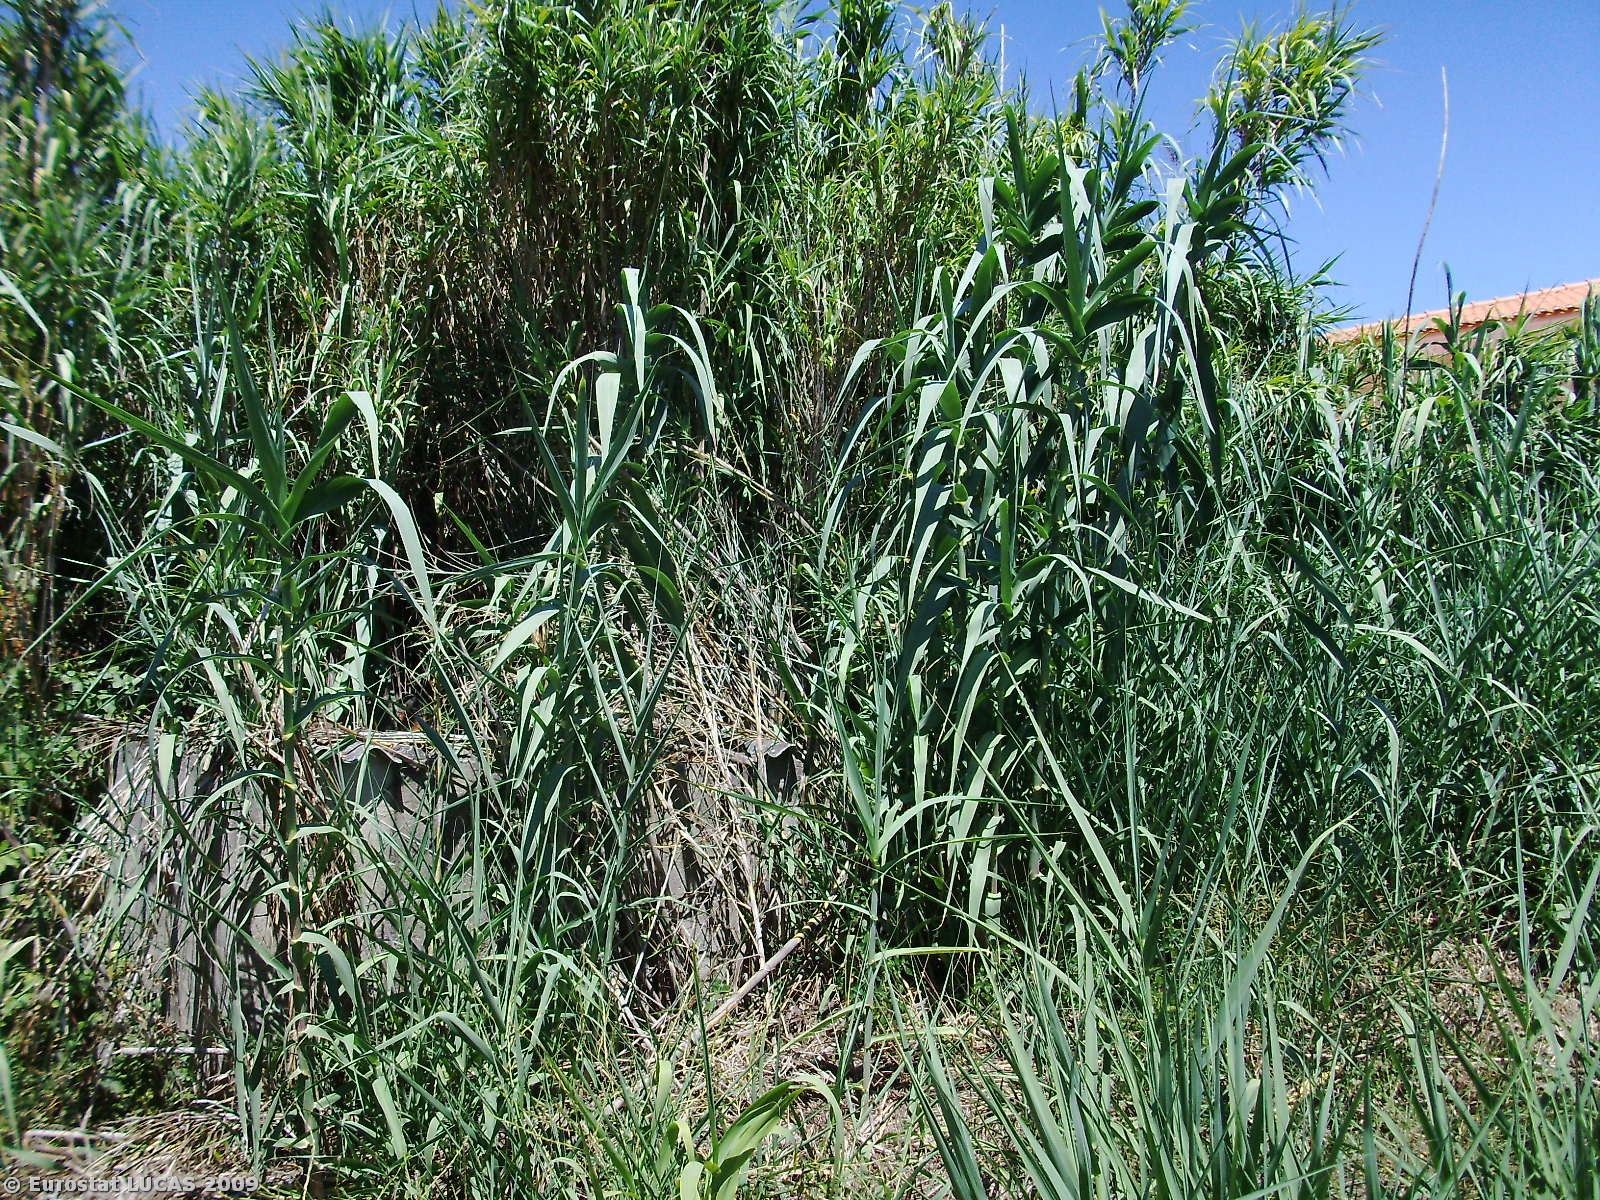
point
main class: Shrubland
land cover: Shrubland without tree cover
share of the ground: > 75 %
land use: Fallow land
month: July
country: PT
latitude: 39.3997
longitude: -9.1448
